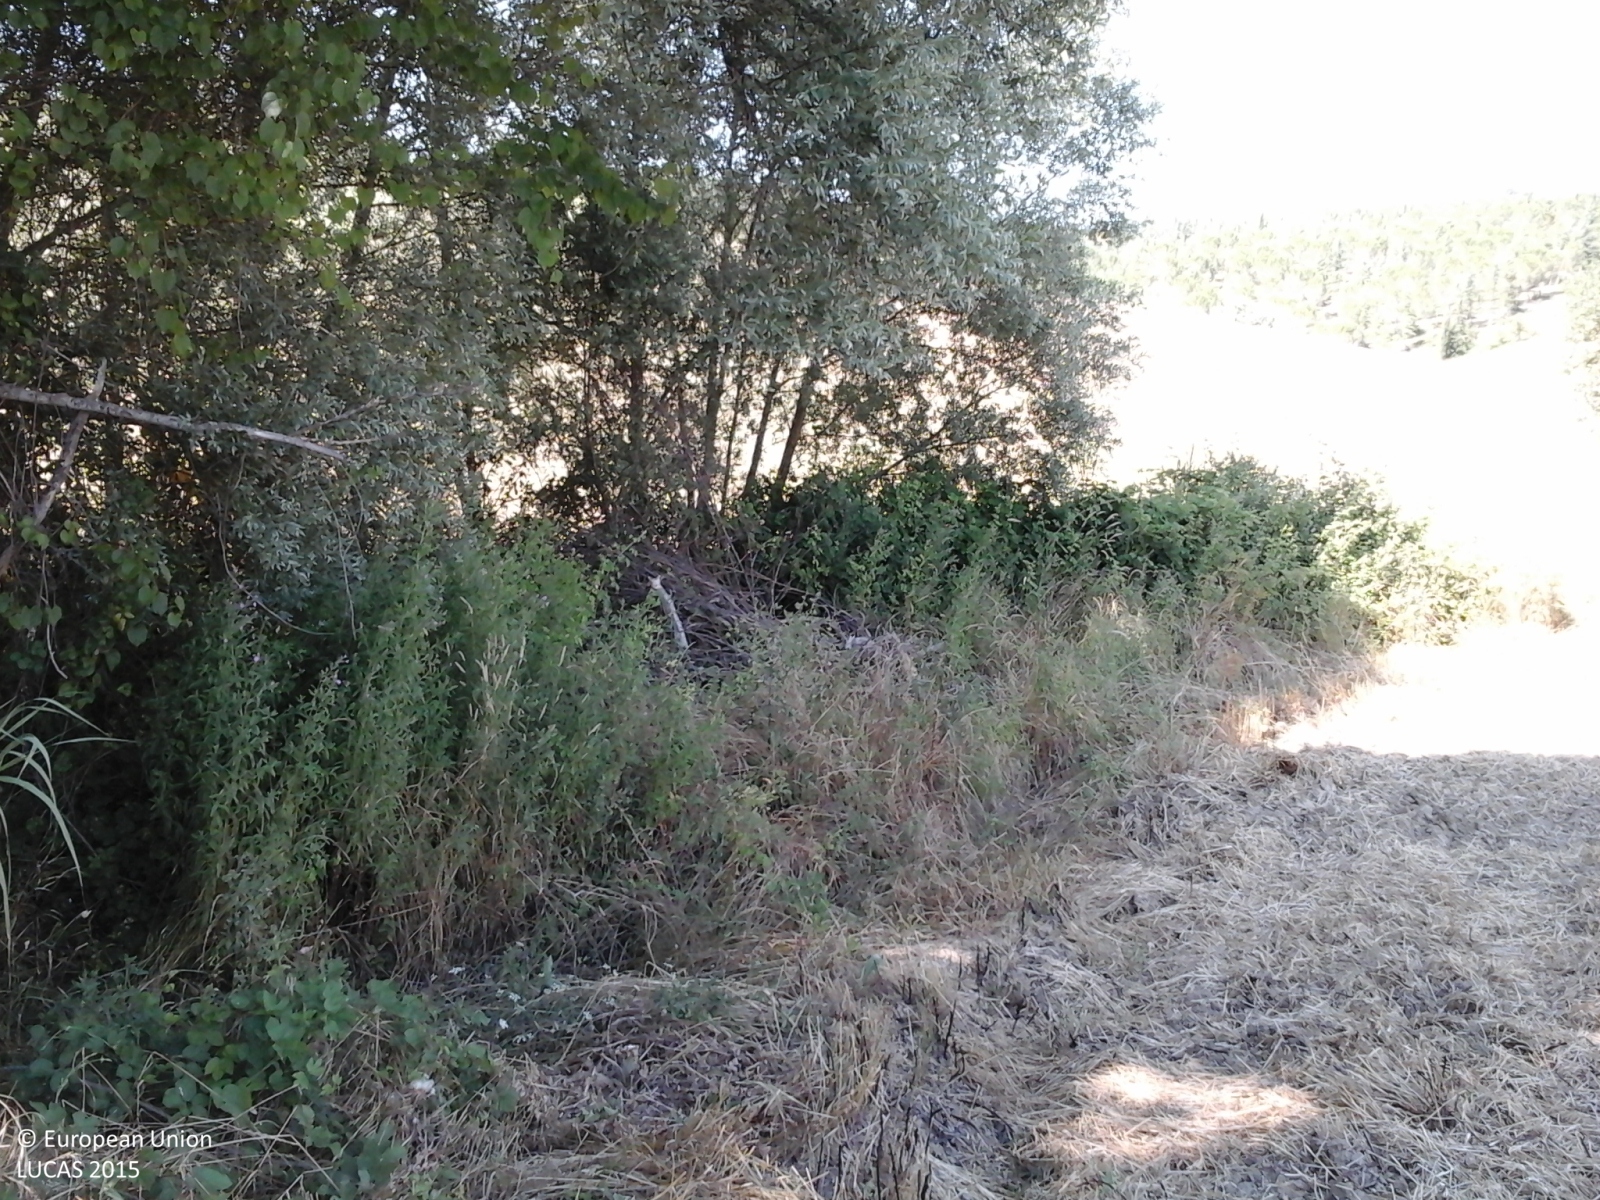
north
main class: Woodland
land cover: Broadleaved woodland
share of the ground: > 75 %
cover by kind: broadleaved forest trees 85 %, shrubs 10 %, herbaceous plants 5 %
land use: Semi-natural and natural areas not in use
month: July
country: IT
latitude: 41.5848
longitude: 14.7218
